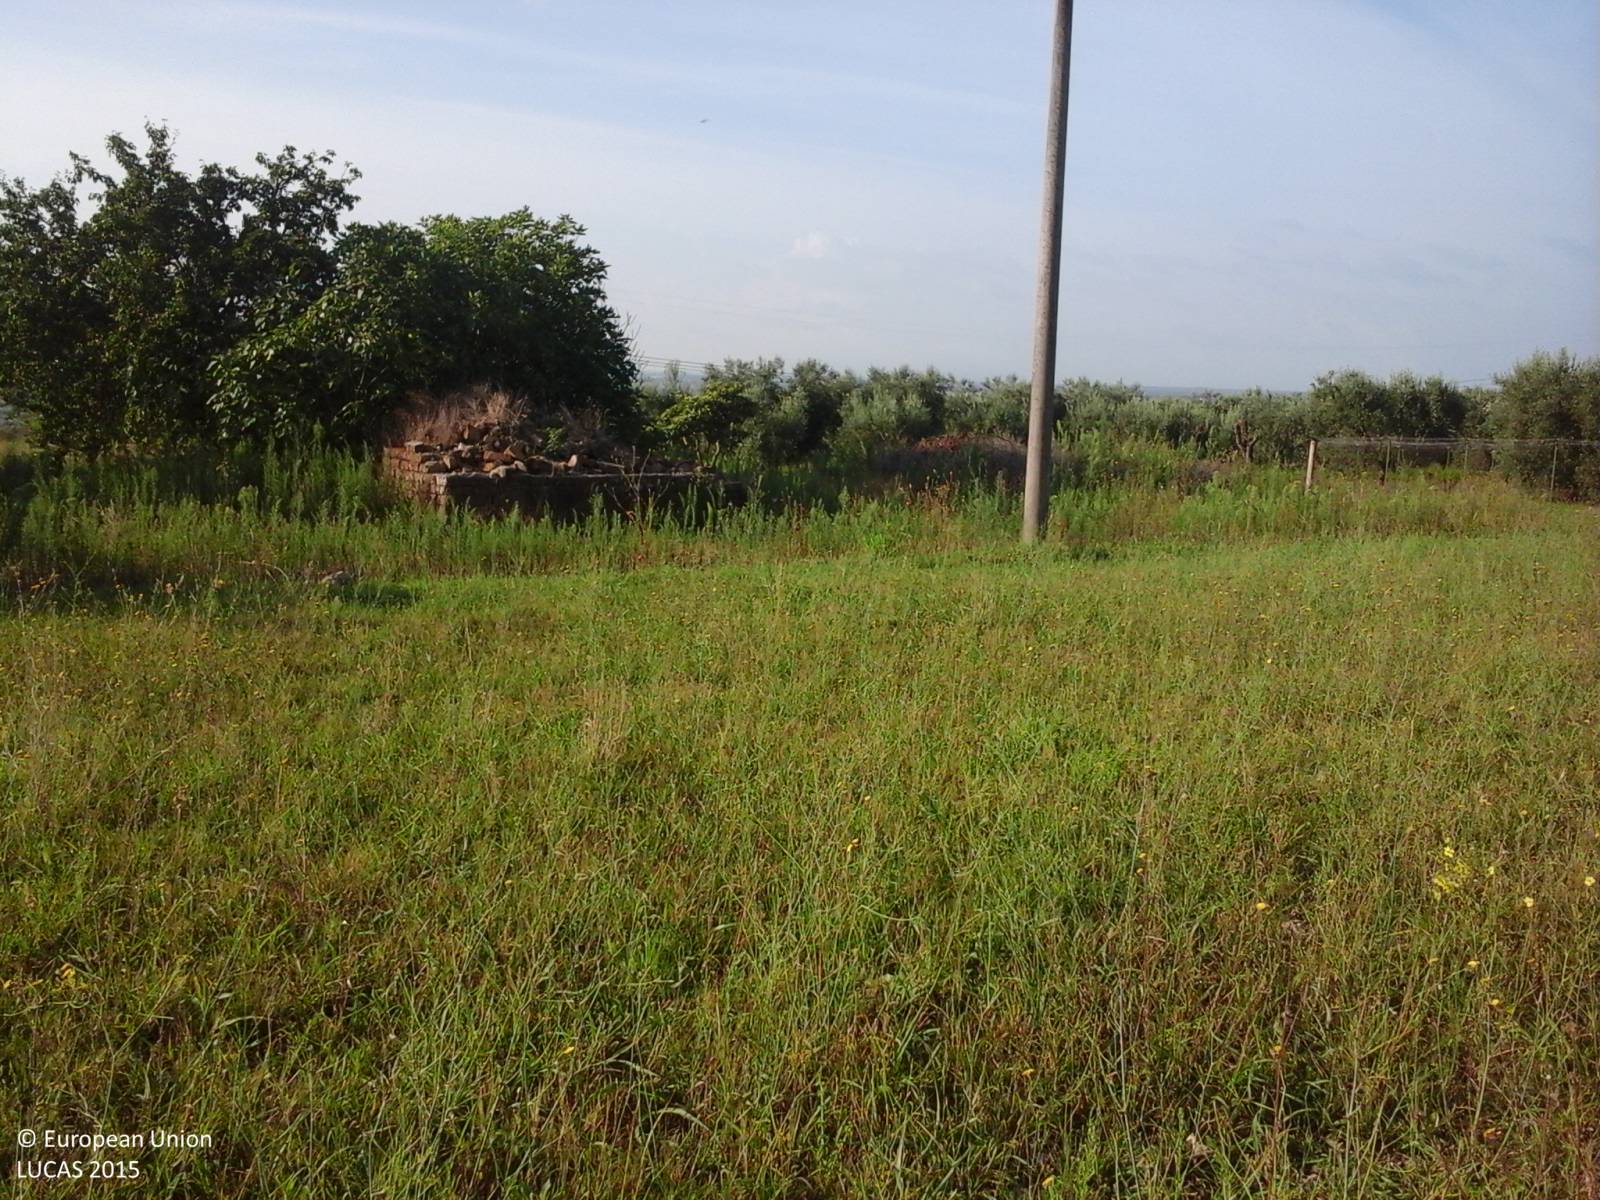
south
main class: Grassland
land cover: Spontaneously vegetated surfaces
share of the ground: > 75 %
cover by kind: herbaceous plants 100 %
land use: Agriculture (excluding fallow land and kitchen gardens)
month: August
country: IT
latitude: 41.4851
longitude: 13.1136
